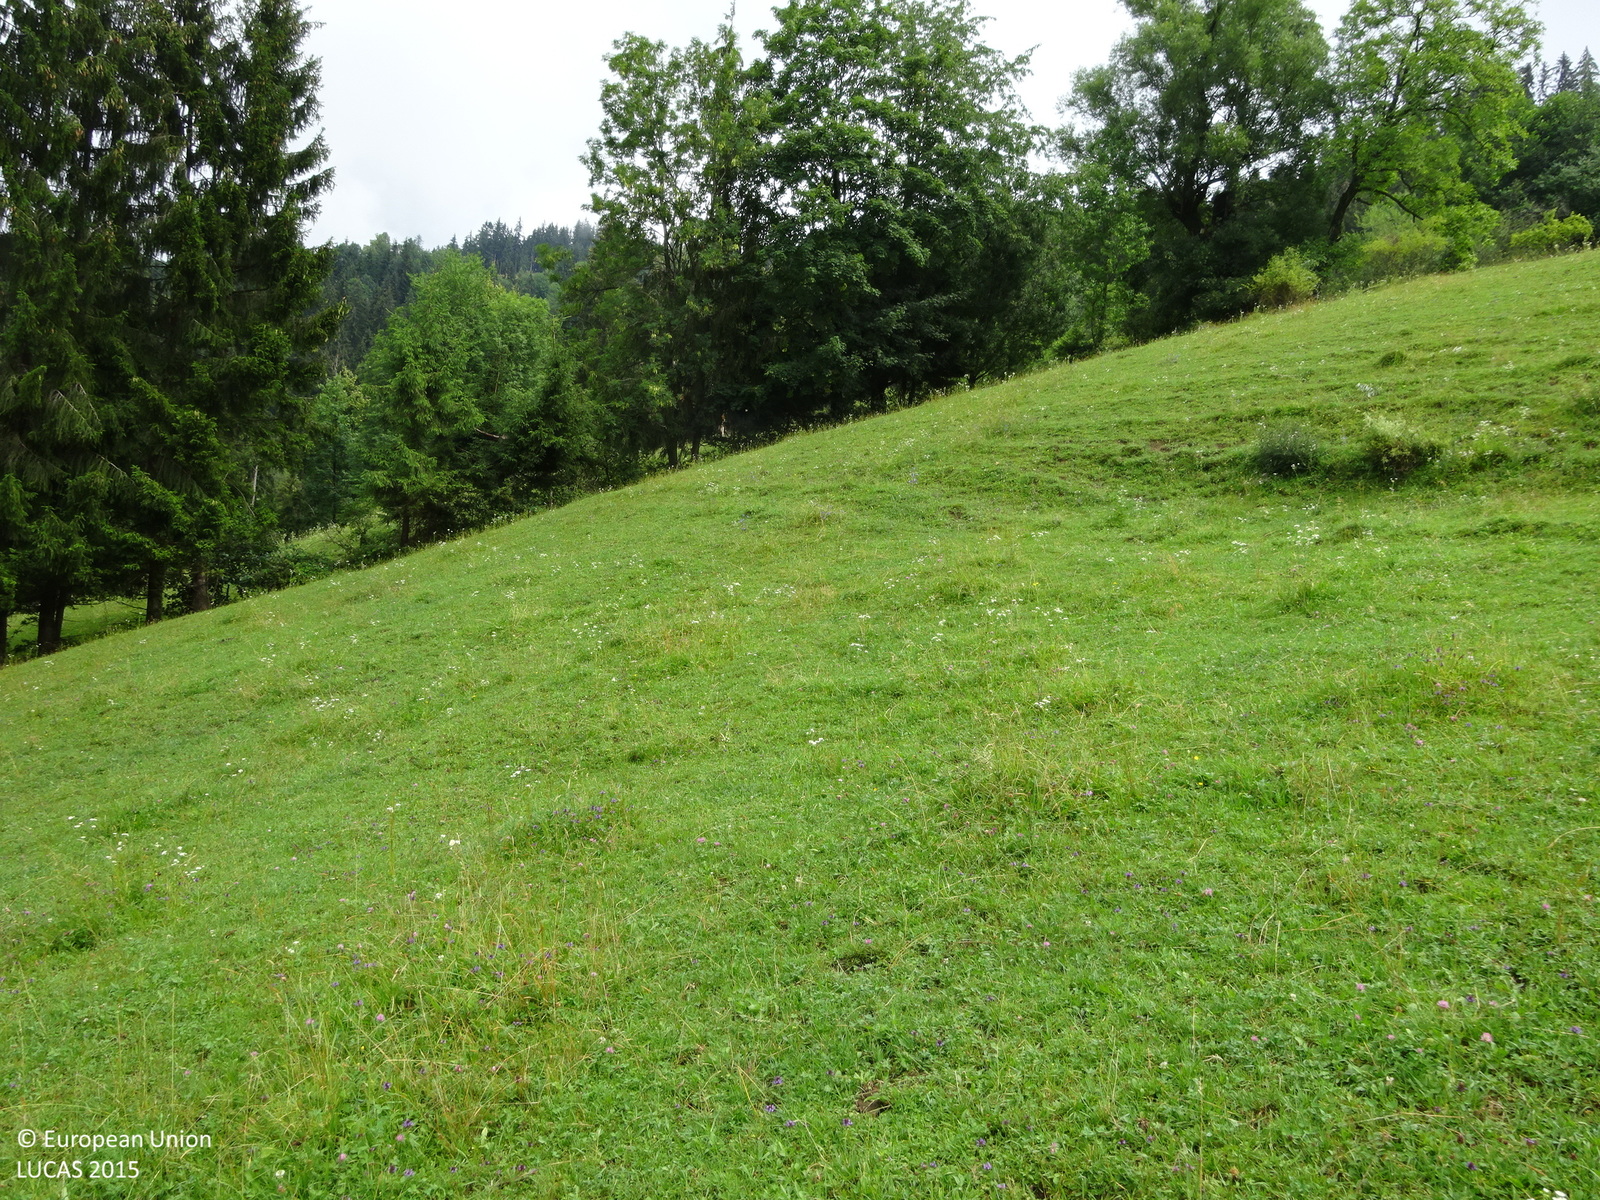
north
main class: Grassland
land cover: Grassland without tree/shrub cover
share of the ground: > 75 %
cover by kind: herbaceous plants 100 %
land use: Agriculture (excluding fallow land and kitchen gardens)
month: July
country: AT
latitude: 47.1304
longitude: 15.1277
